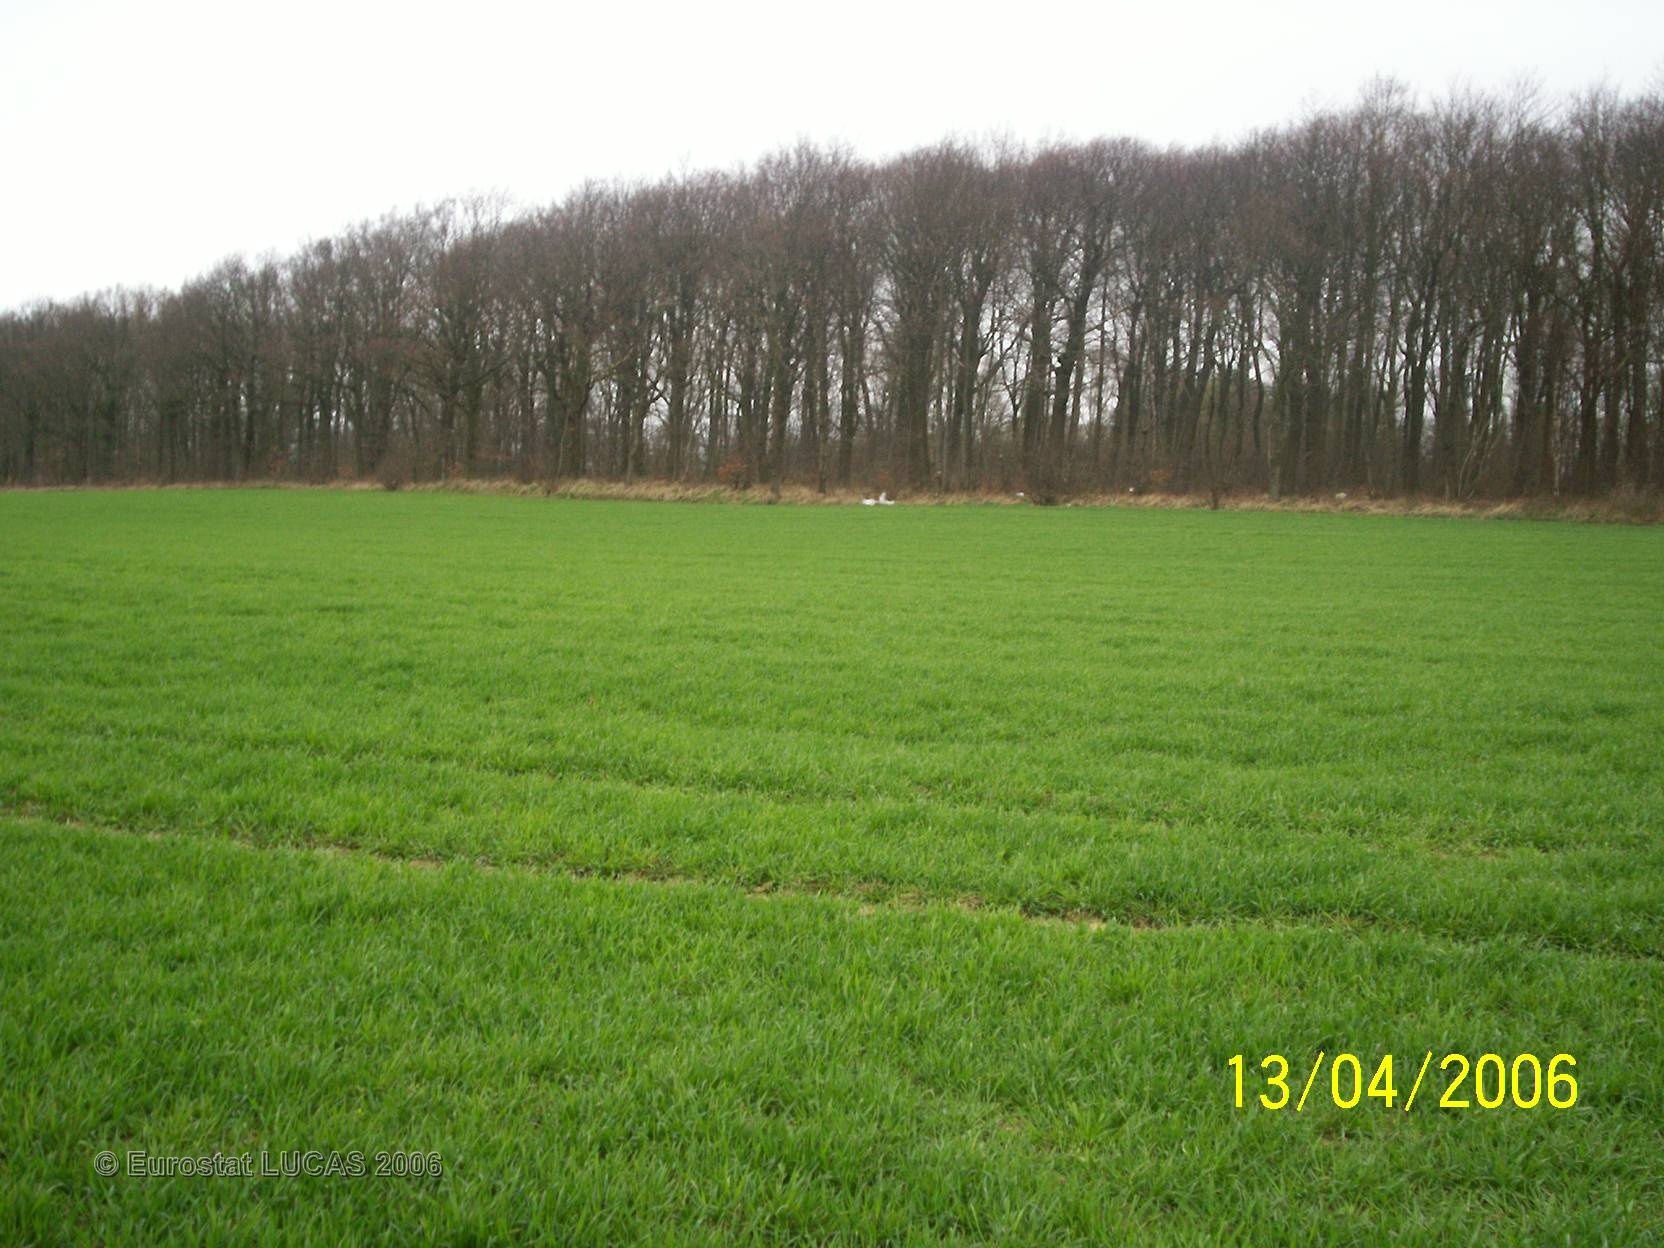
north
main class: Cropland
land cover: Common wheat
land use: Agriculture (excluding fallow land and kitchen gardens)
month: April
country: FR
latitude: 50.4988
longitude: 2.5297
